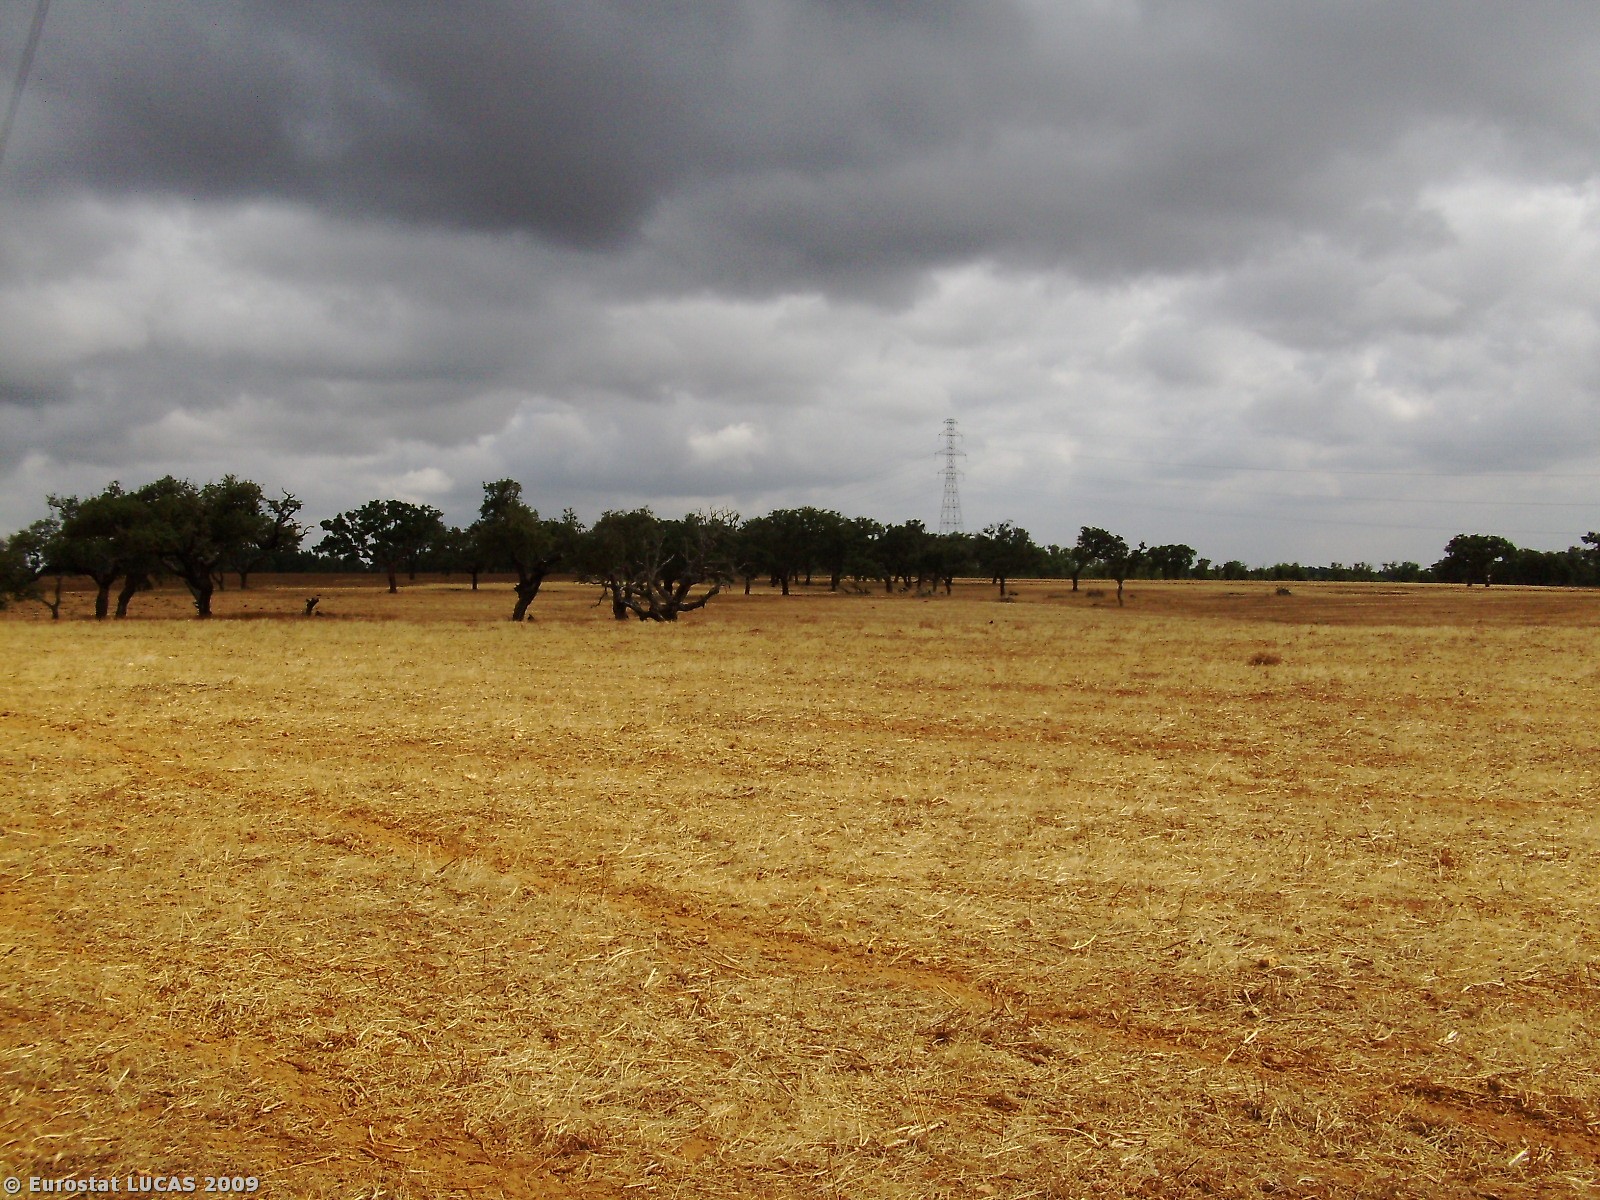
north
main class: Grassland
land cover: Spontaneously vegetated surfaces
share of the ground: > 75 %
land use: Fallow land
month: June
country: PT
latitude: 37.8634
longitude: -8.6750
